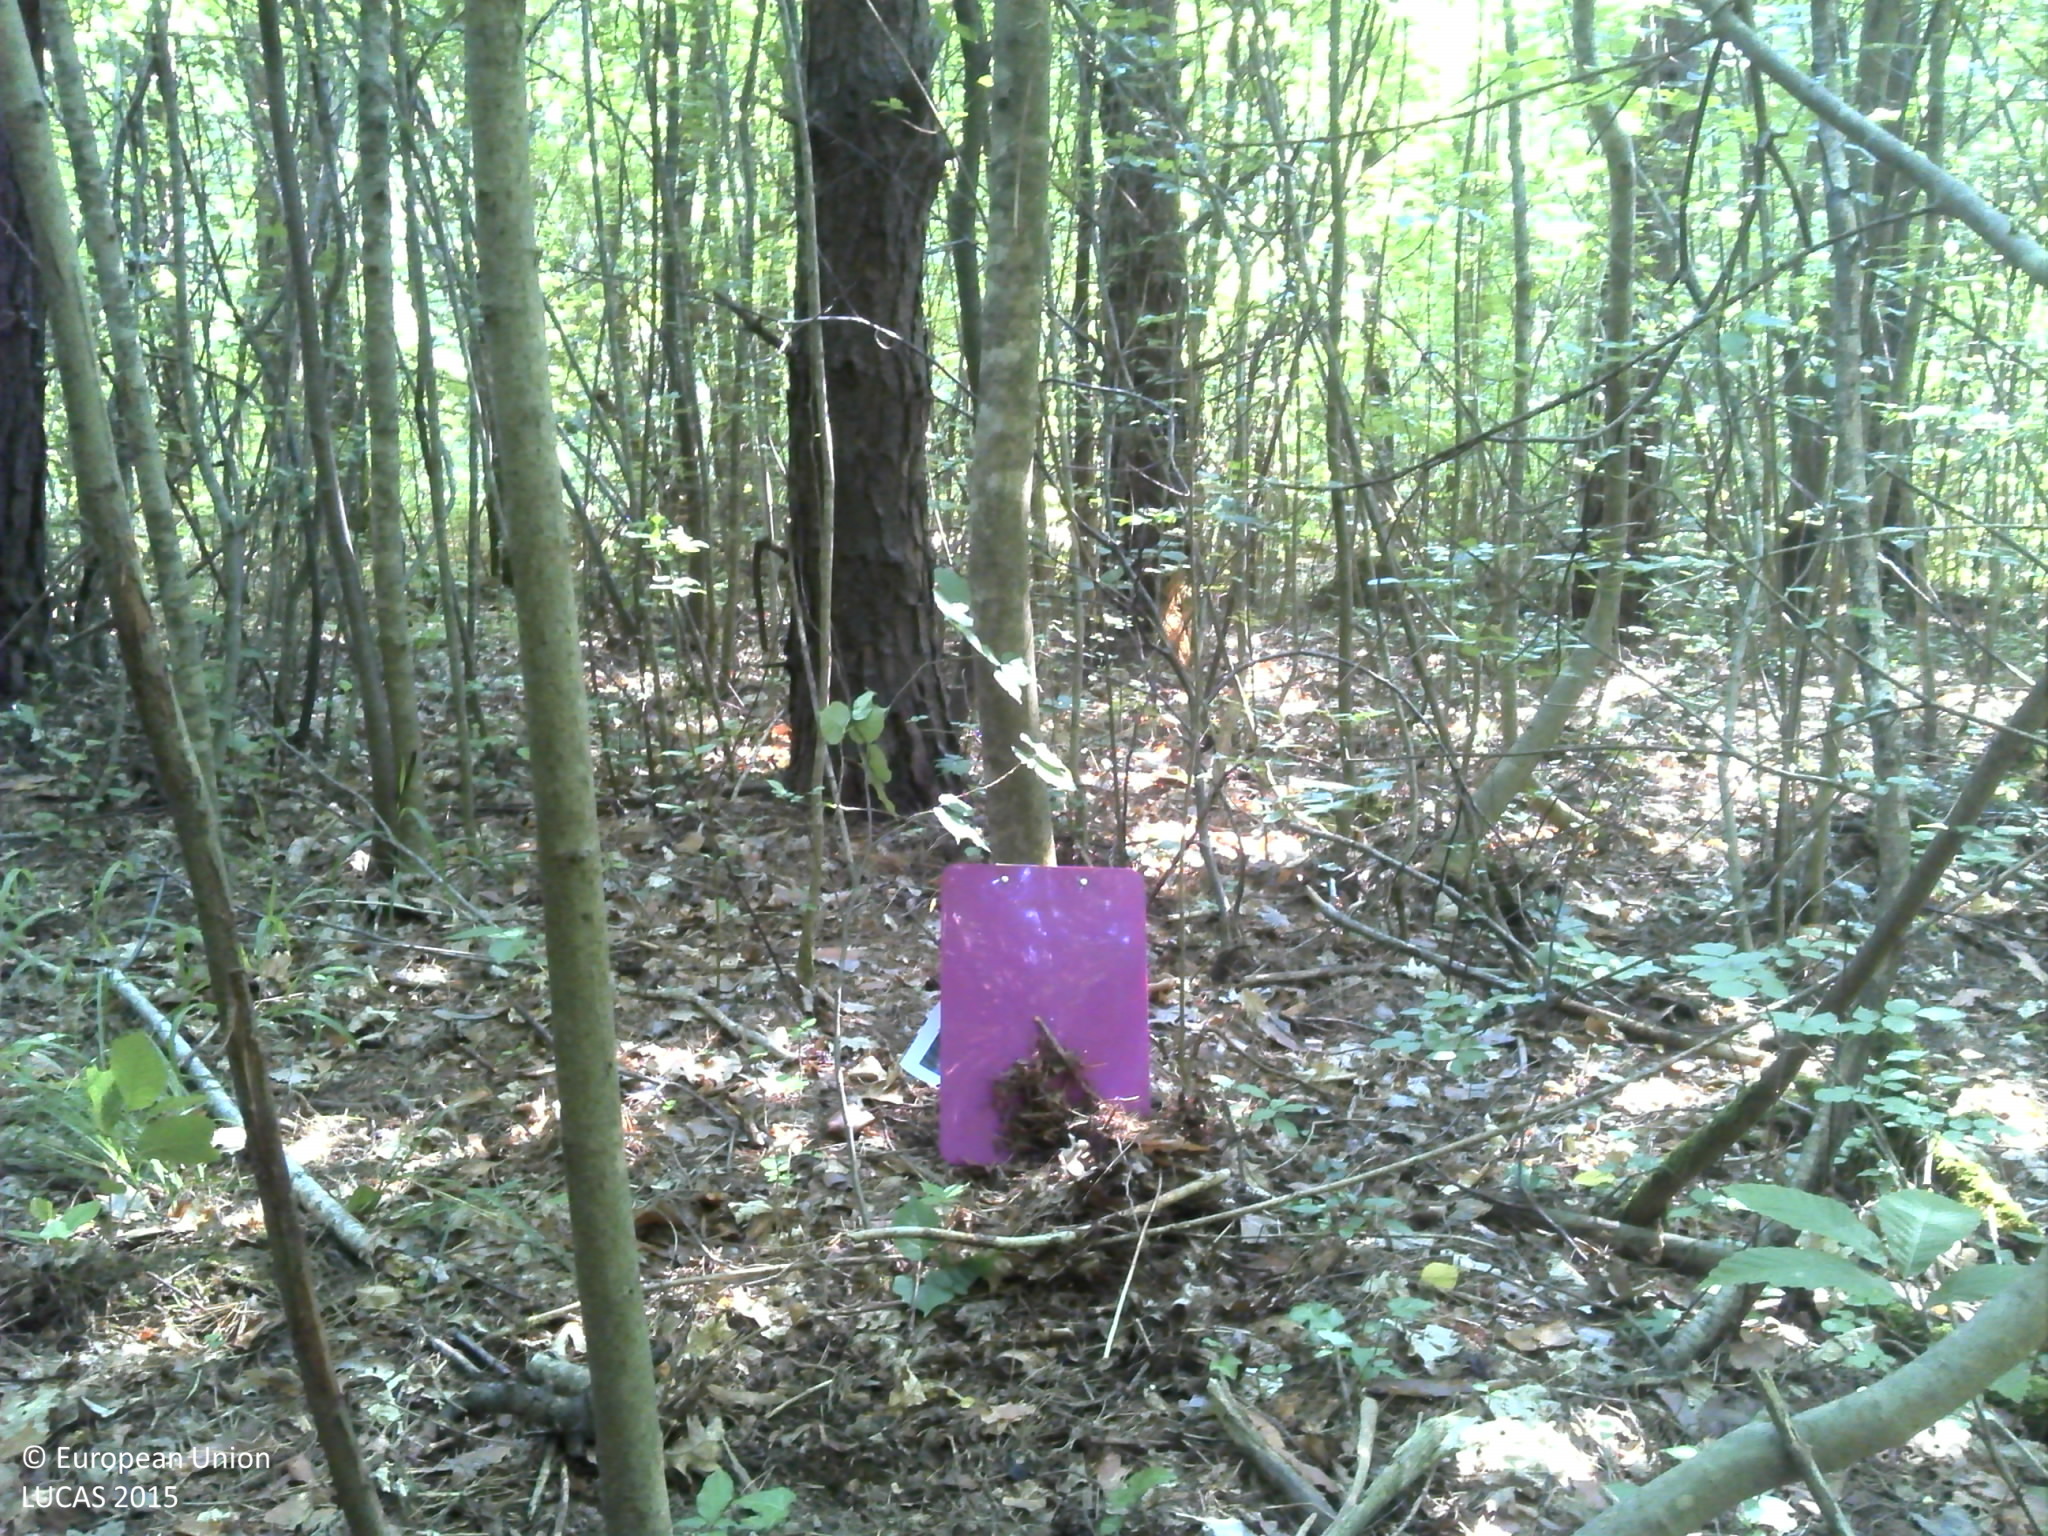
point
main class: Woodland
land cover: Broadleaved woodland
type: beech forest
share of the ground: > 75 %
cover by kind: broadleaved forest trees 100 %
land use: Forestry
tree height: > 5 m
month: June
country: HR
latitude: 45.4609
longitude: 17.6625
